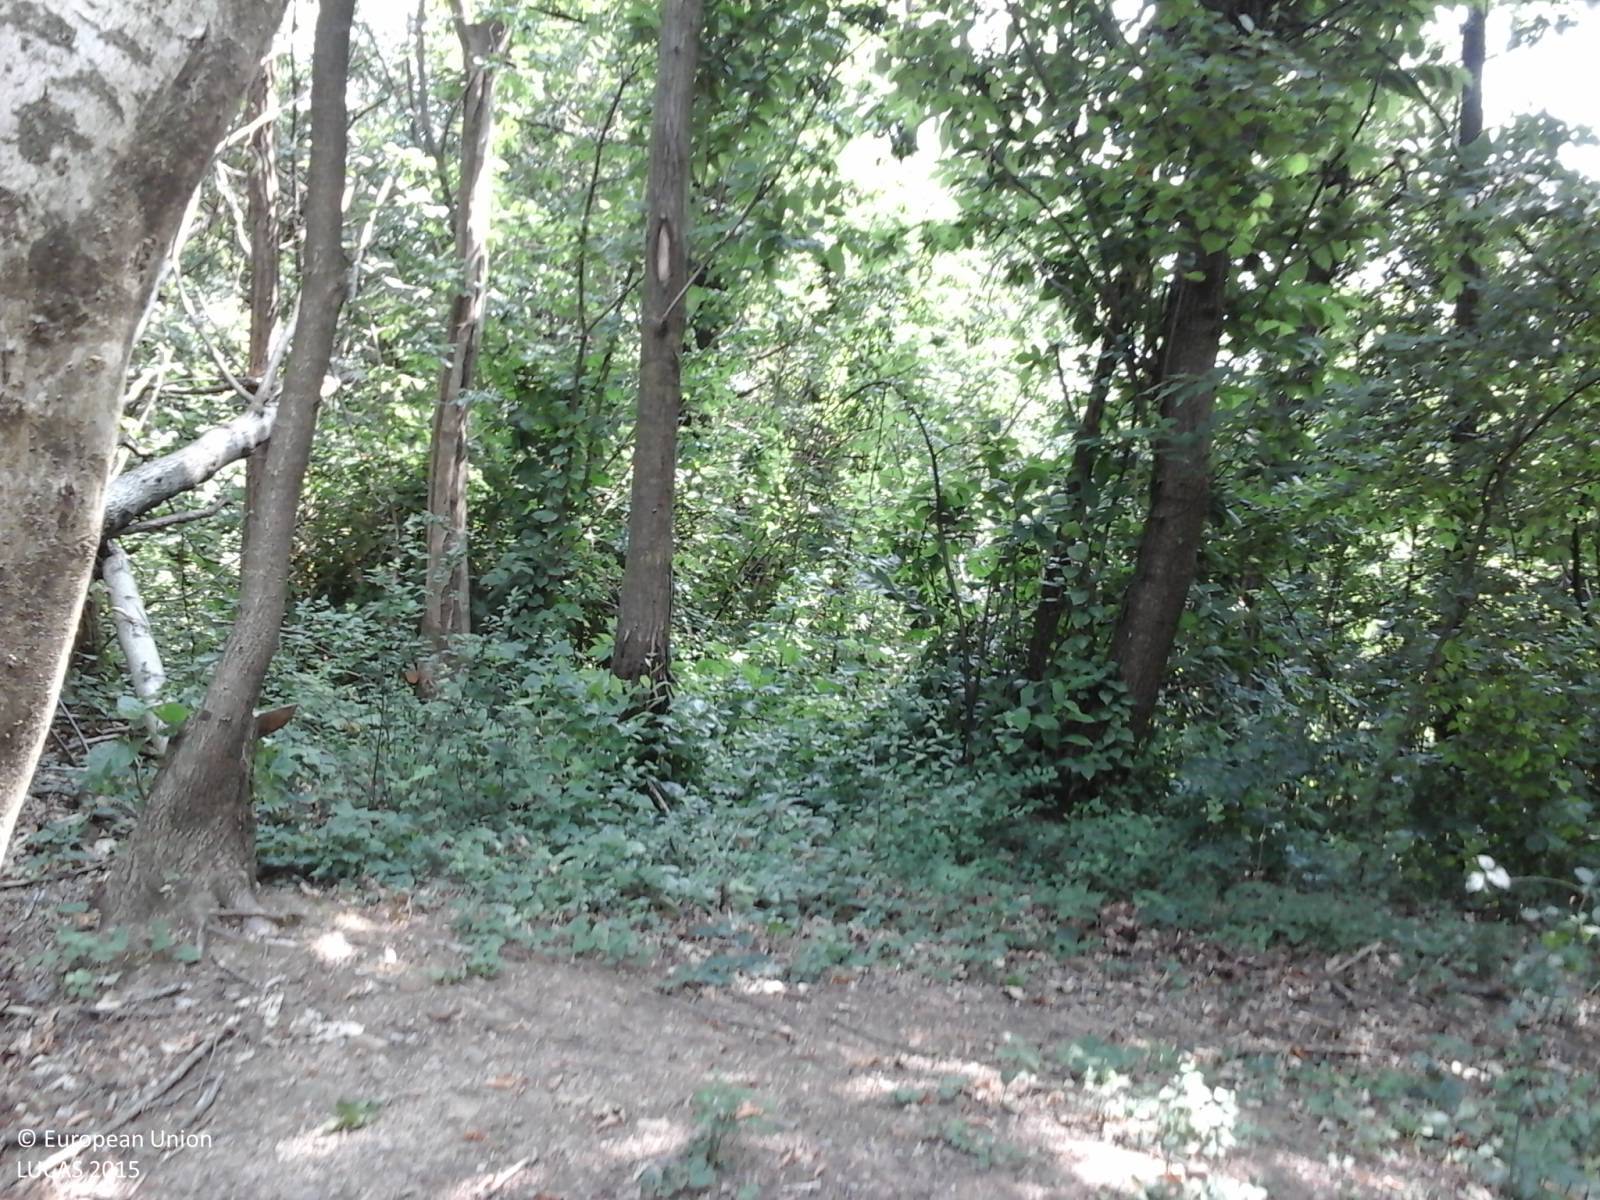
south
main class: Woodland
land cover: Broadleaved woodland
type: thermophilous deciduous forest
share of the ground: > 75 %
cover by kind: broadleaved forest trees 90 %, shrubs 10 %
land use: Forestry
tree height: > 5 m
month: June
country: IT
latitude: 46.1968
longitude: 13.1455
